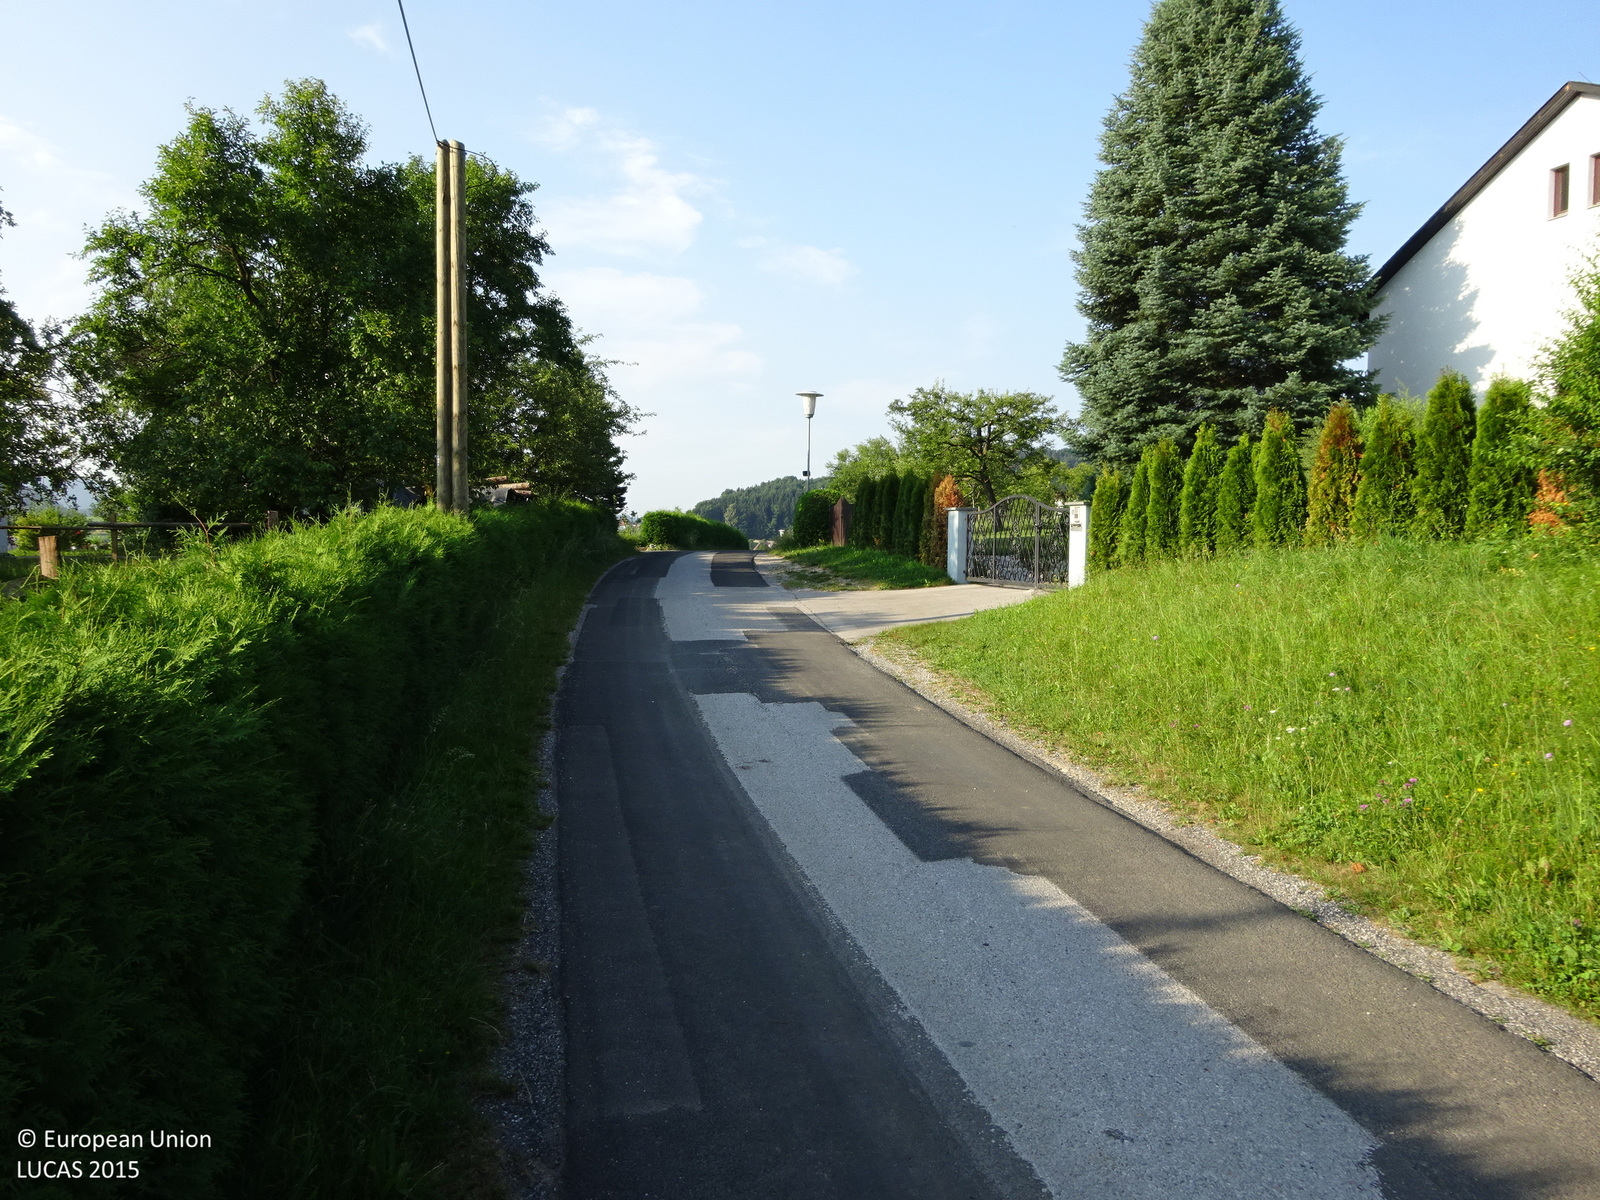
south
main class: Cropland
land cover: Apple fruit
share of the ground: > 75 %
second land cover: Grassland without tree/shrub cover
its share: > 75 %
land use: Agriculture (excluding fallow land and kitchen gardens)
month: July
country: AT
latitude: 47.1408
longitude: 15.2872
